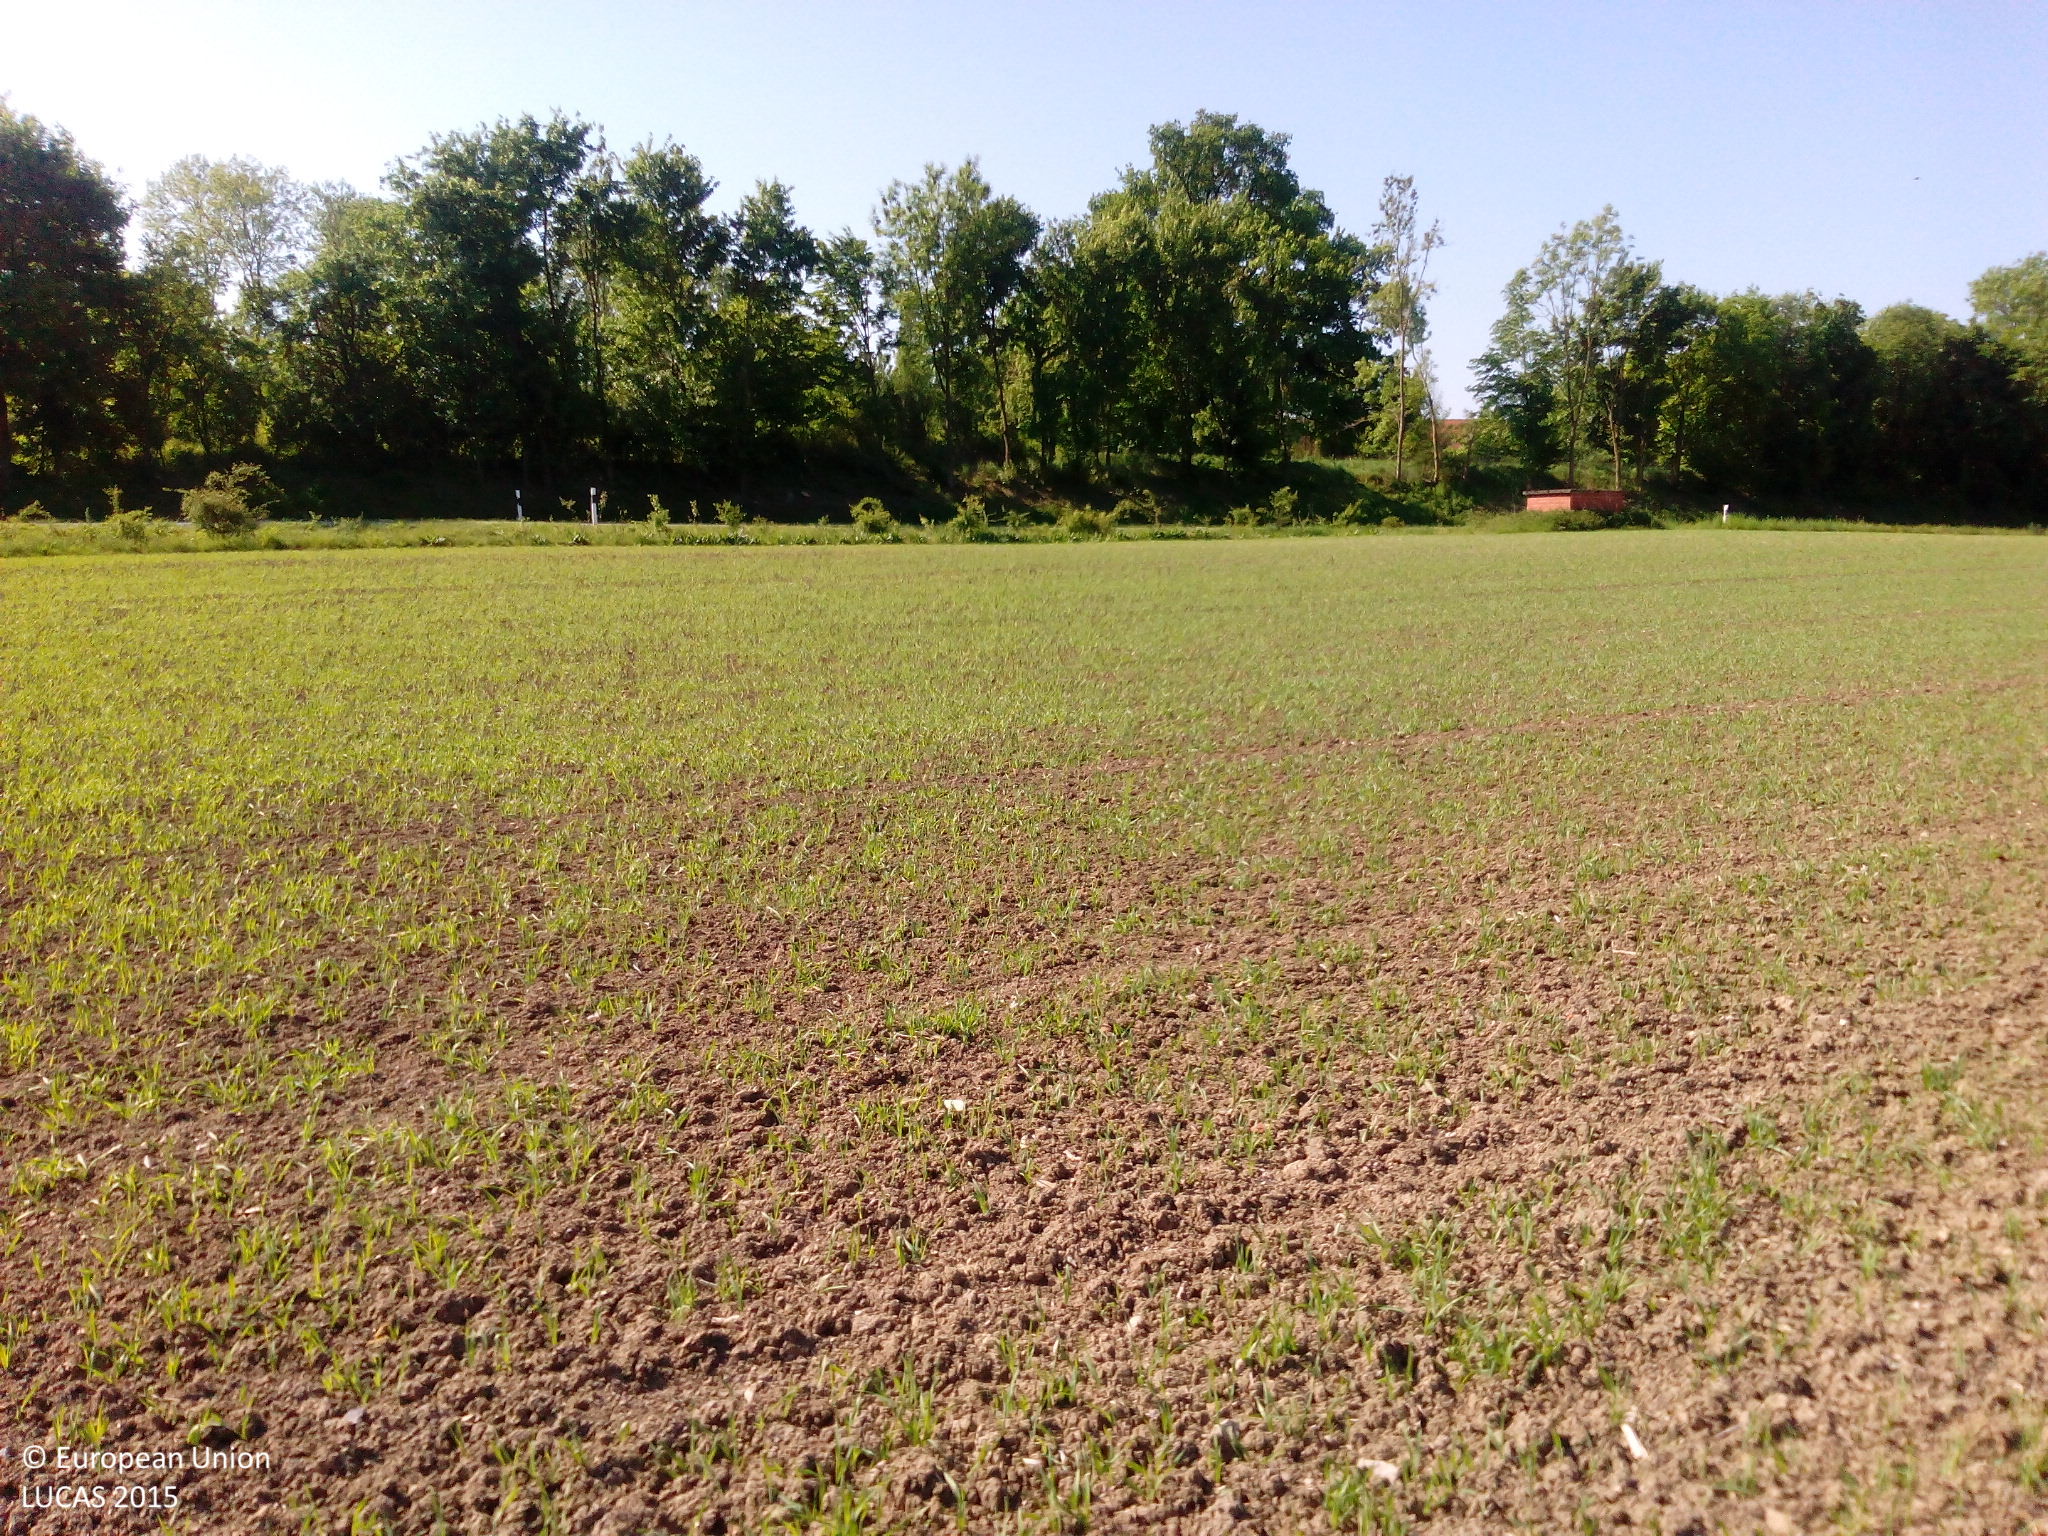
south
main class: Cropland
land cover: Common wheat
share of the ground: 25 - 50 %
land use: Agriculture (excluding fallow land and kitchen gardens)
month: May
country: DE
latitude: 51.8749
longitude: 7.9814
